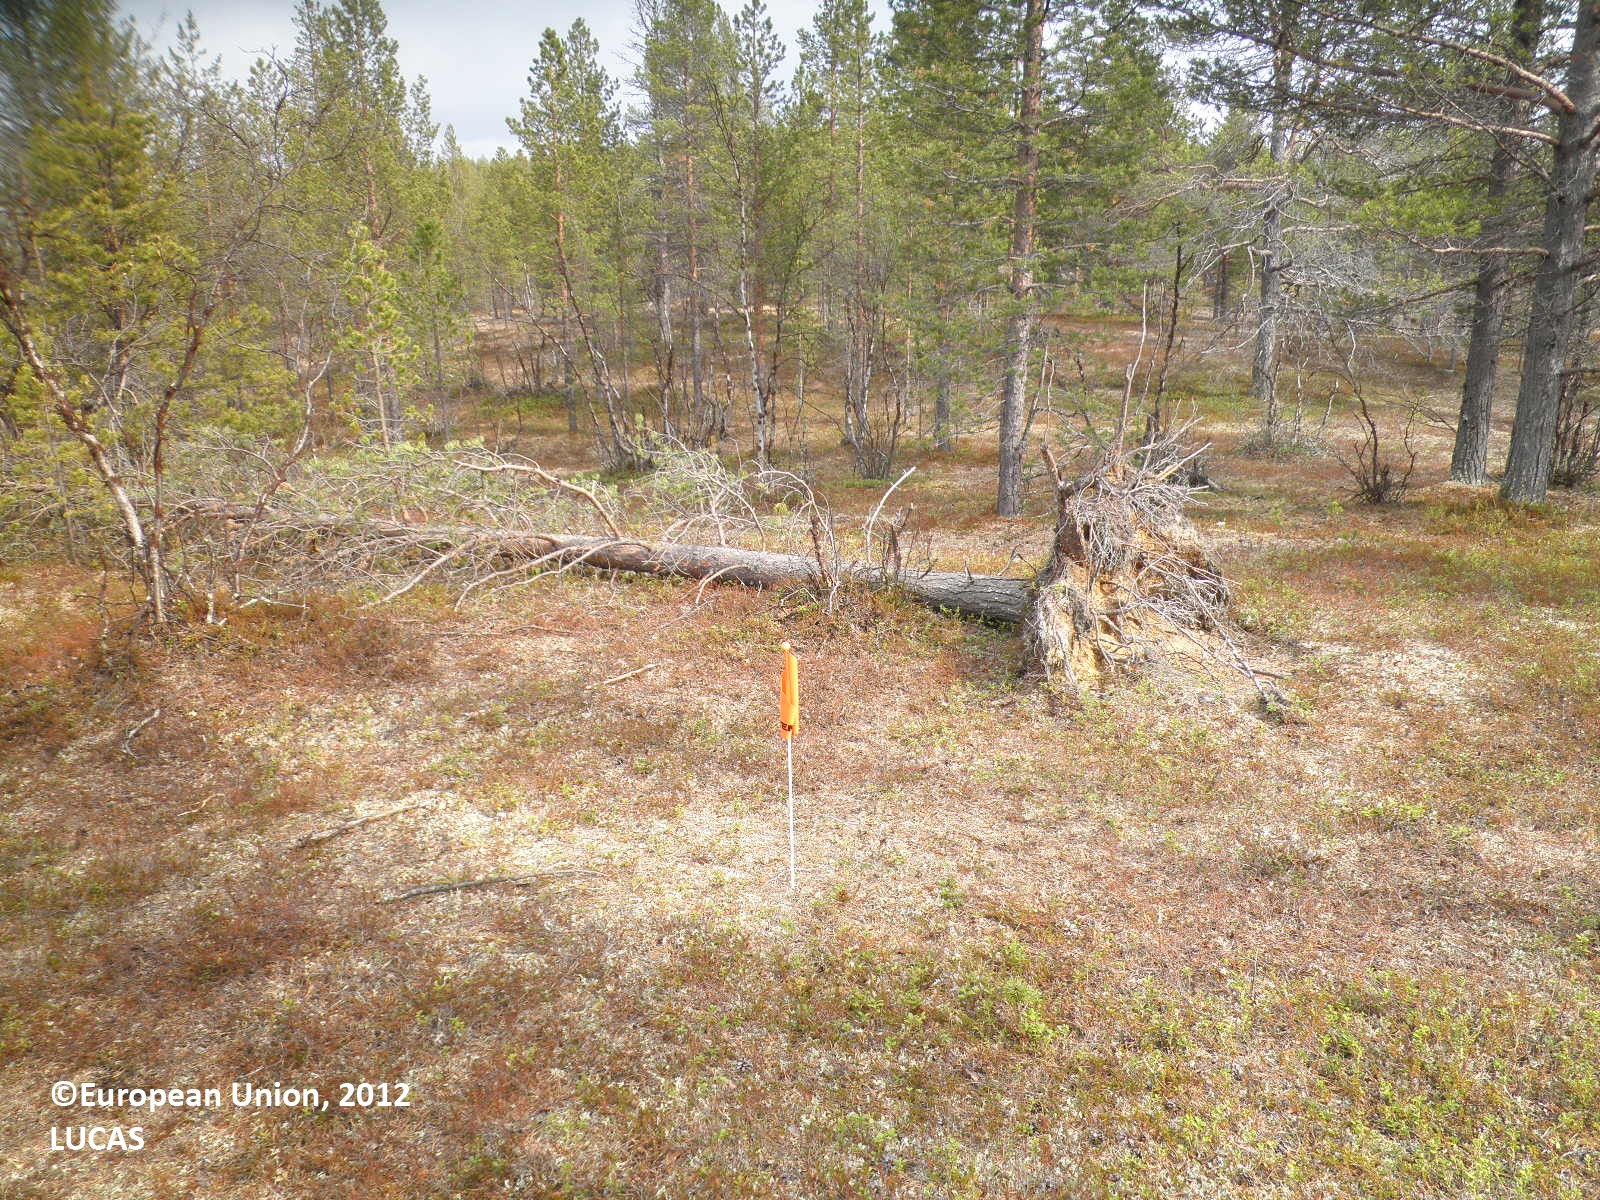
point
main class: Woodland
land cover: Pine dominated mixed woodland
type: boreal forest
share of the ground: > 75 %
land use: Forestry
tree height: > 5 m
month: May
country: FI
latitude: 69.2476
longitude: 26.8147
